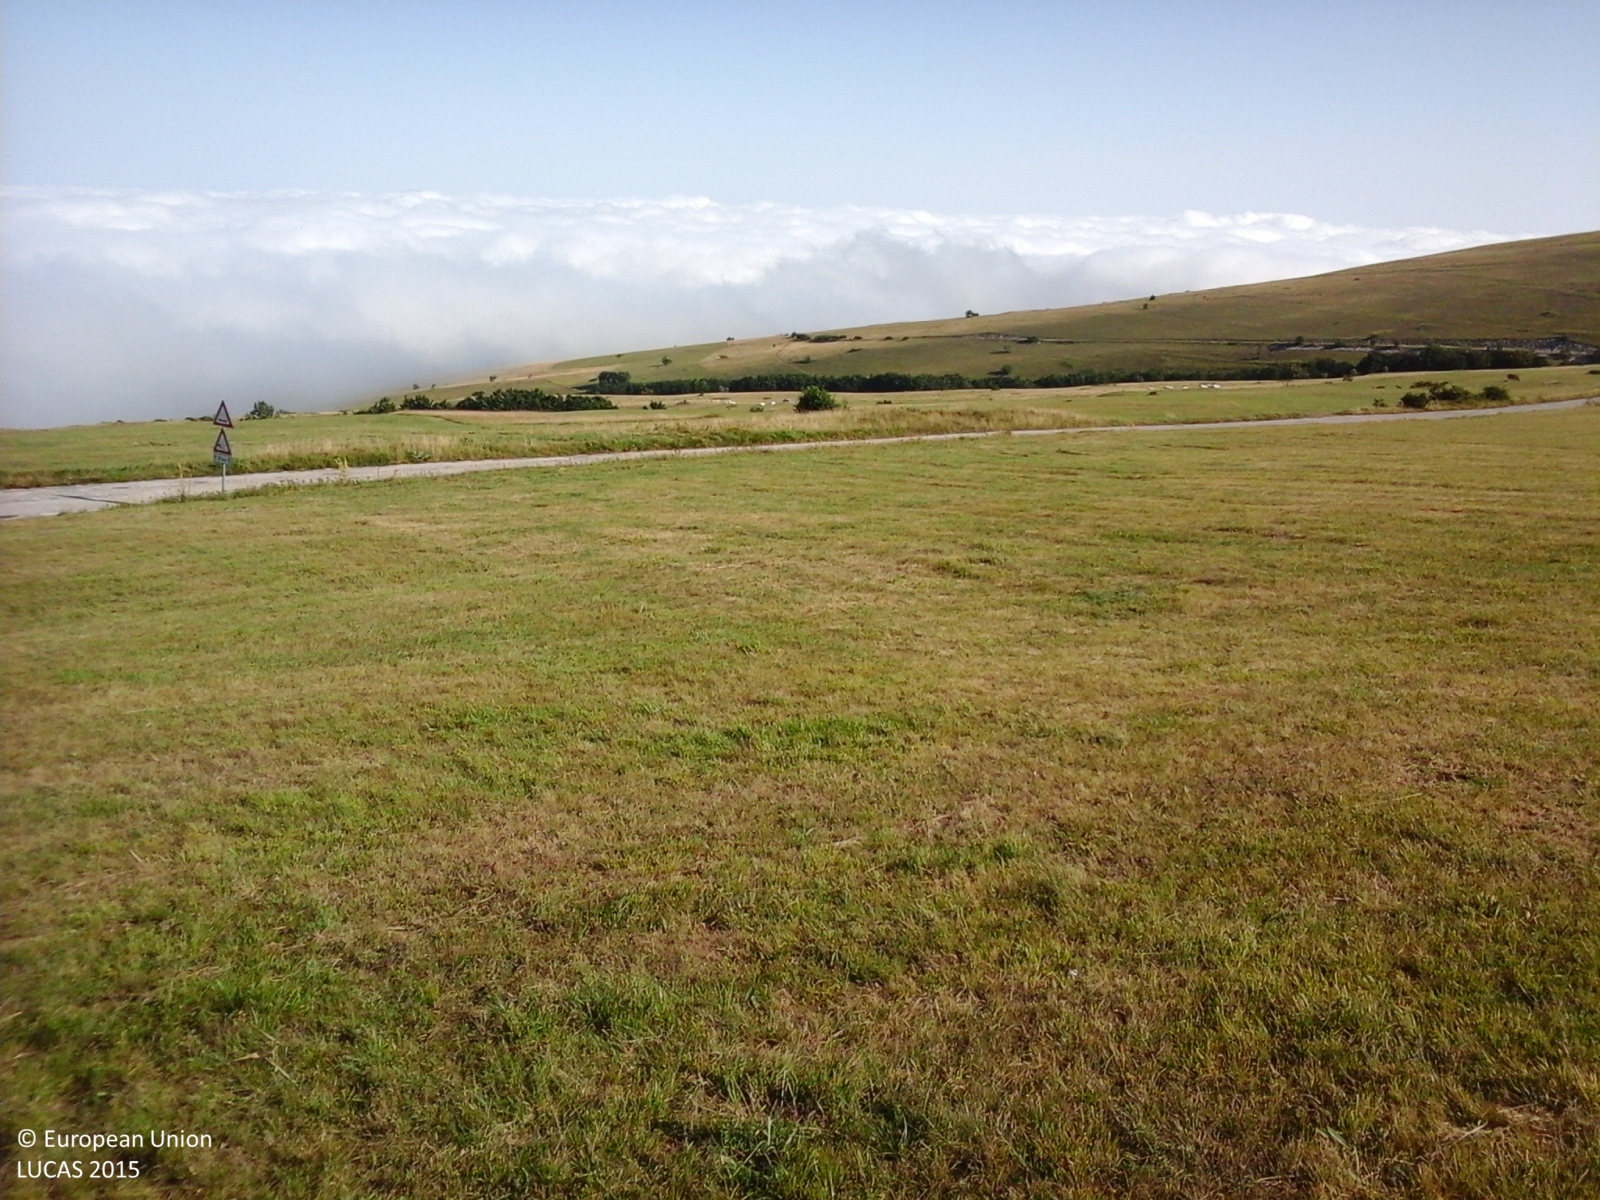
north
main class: Grassland
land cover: Grassland without tree/shrub cover
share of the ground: > 75 %
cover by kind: herbaceous plants 100 %
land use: Agriculture (excluding fallow land and kitchen gardens)
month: August
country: IT
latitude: 43.0185
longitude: 13.2181
